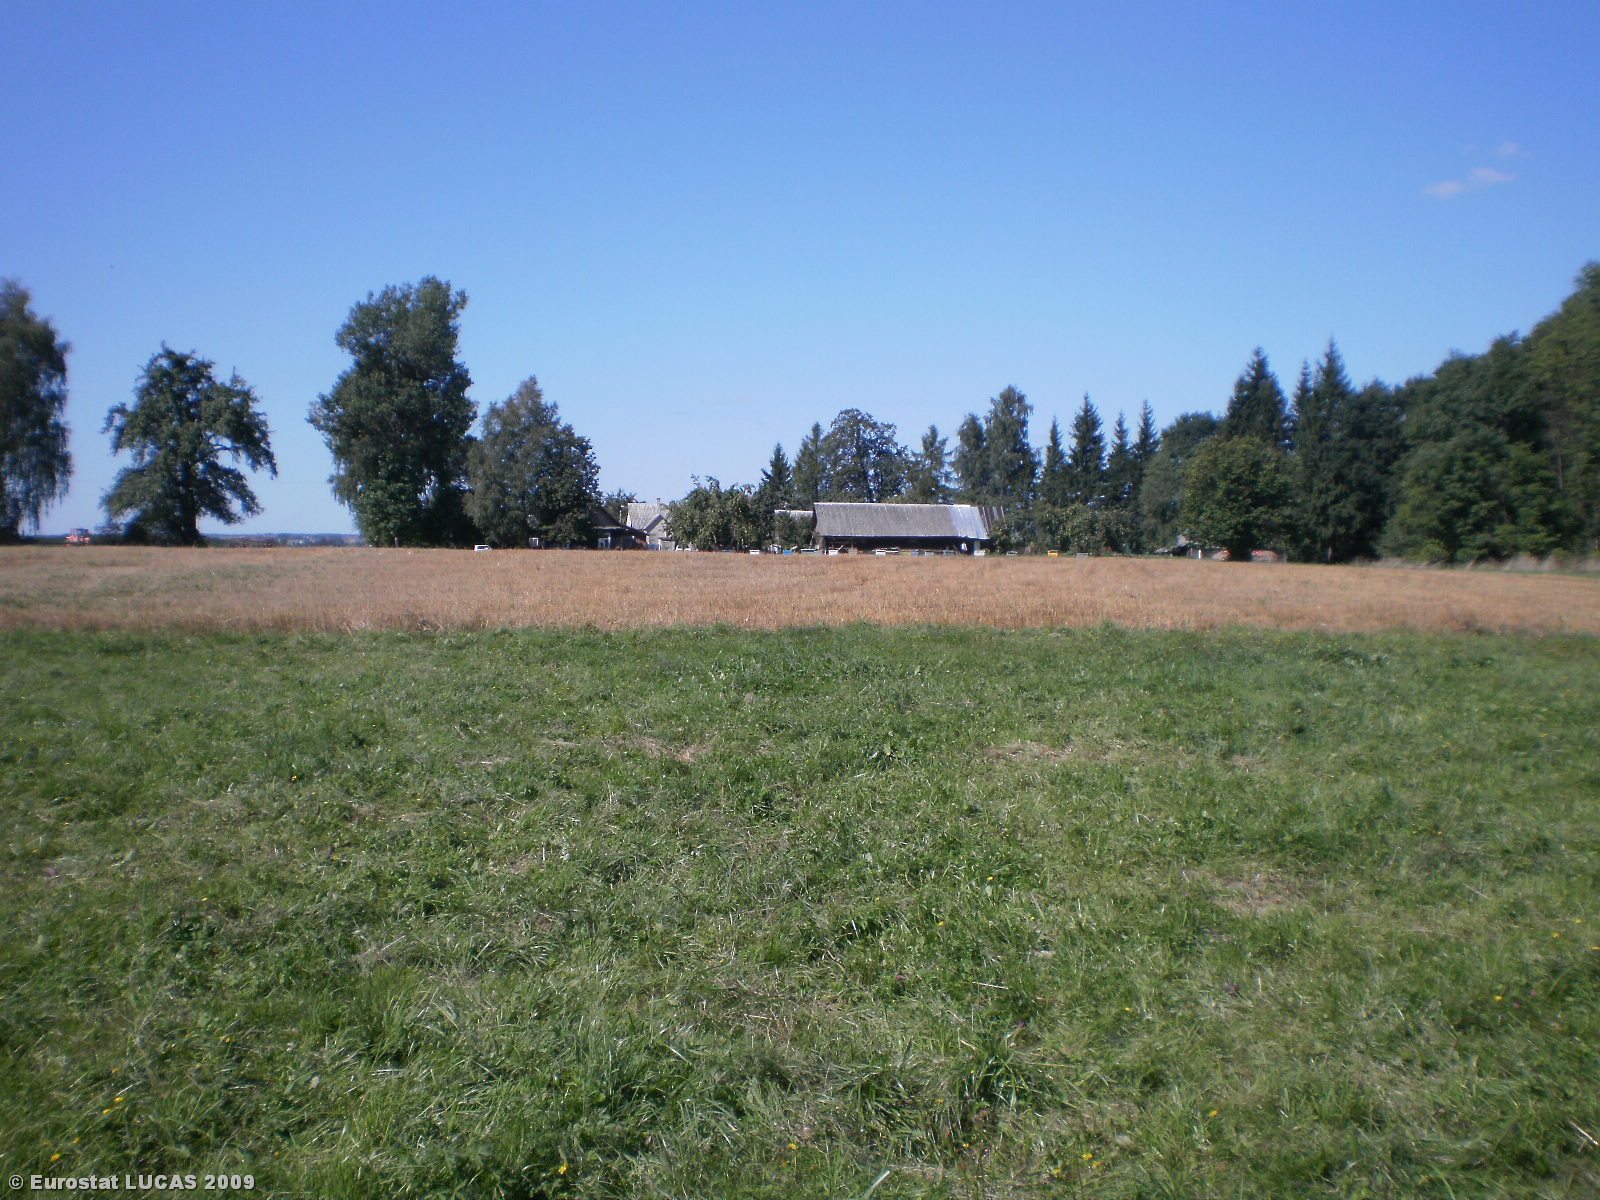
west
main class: Grassland
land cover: Grassland without tree/shrub cover
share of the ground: > 75 %
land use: Agriculture (excluding fallow land and kitchen gardens)
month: August
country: LT
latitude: 54.8018
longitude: 24.7146
